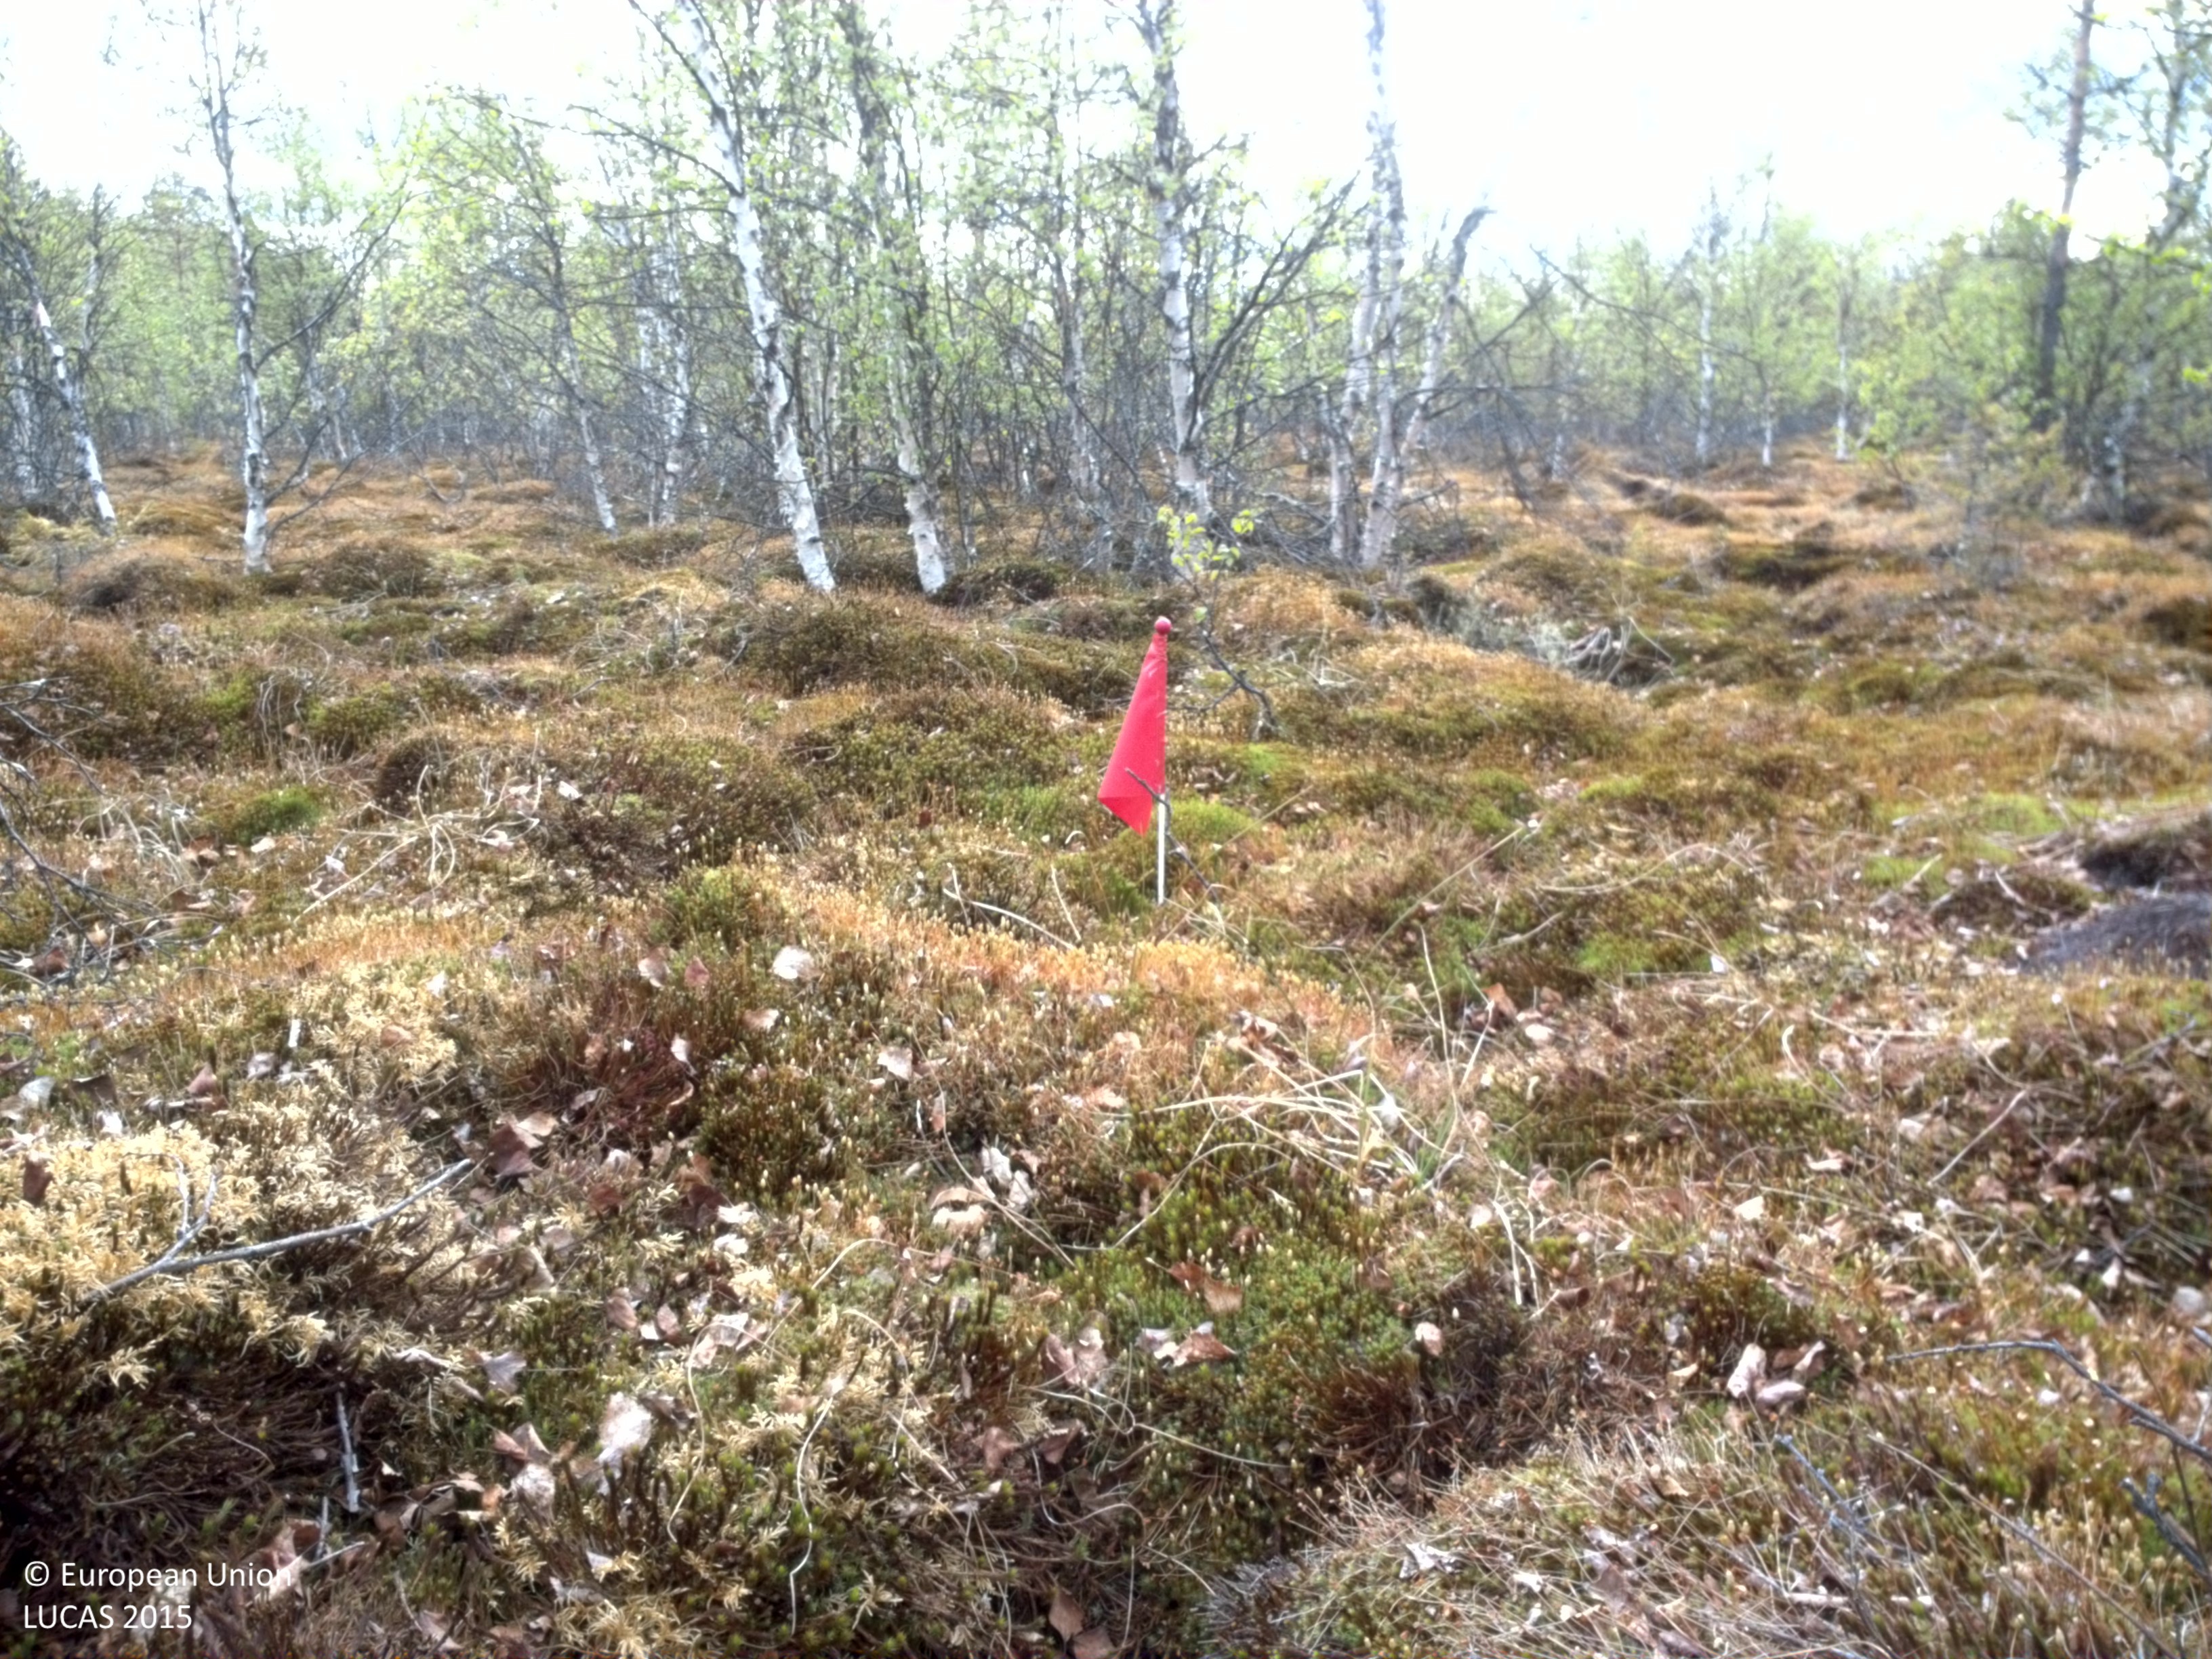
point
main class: Woodland
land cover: Broadleaved woodland
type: boreal forest
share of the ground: 25 - 50 %
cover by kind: lichens and mosses 60 %, broadleaved forest trees 40 %
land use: Forestry
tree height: < 5 m
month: June
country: SE
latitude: 66.9034
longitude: 21.5857
